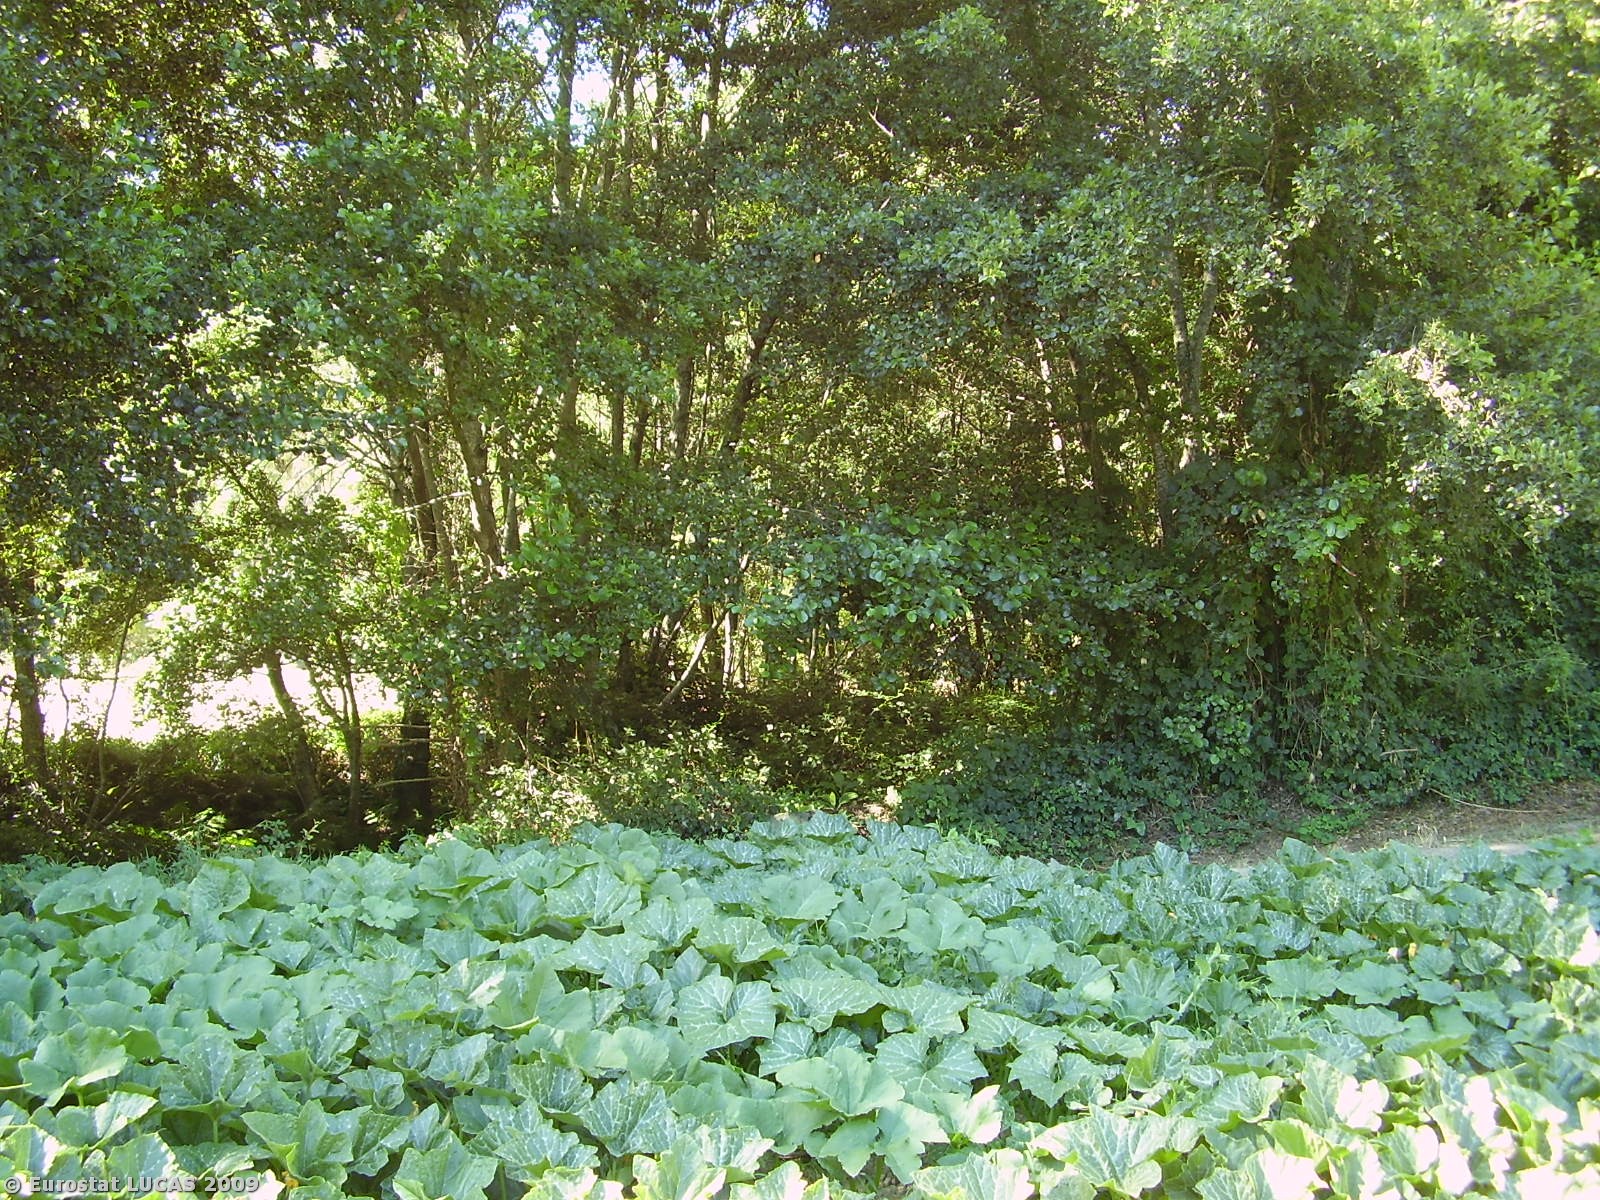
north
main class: Cropland
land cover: Mixed cereals for fodder
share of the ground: > 75 %
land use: Agriculture (excluding fallow land and kitchen gardens)
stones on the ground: < 10 %
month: July
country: PT
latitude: 41.6361
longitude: -7.3768
